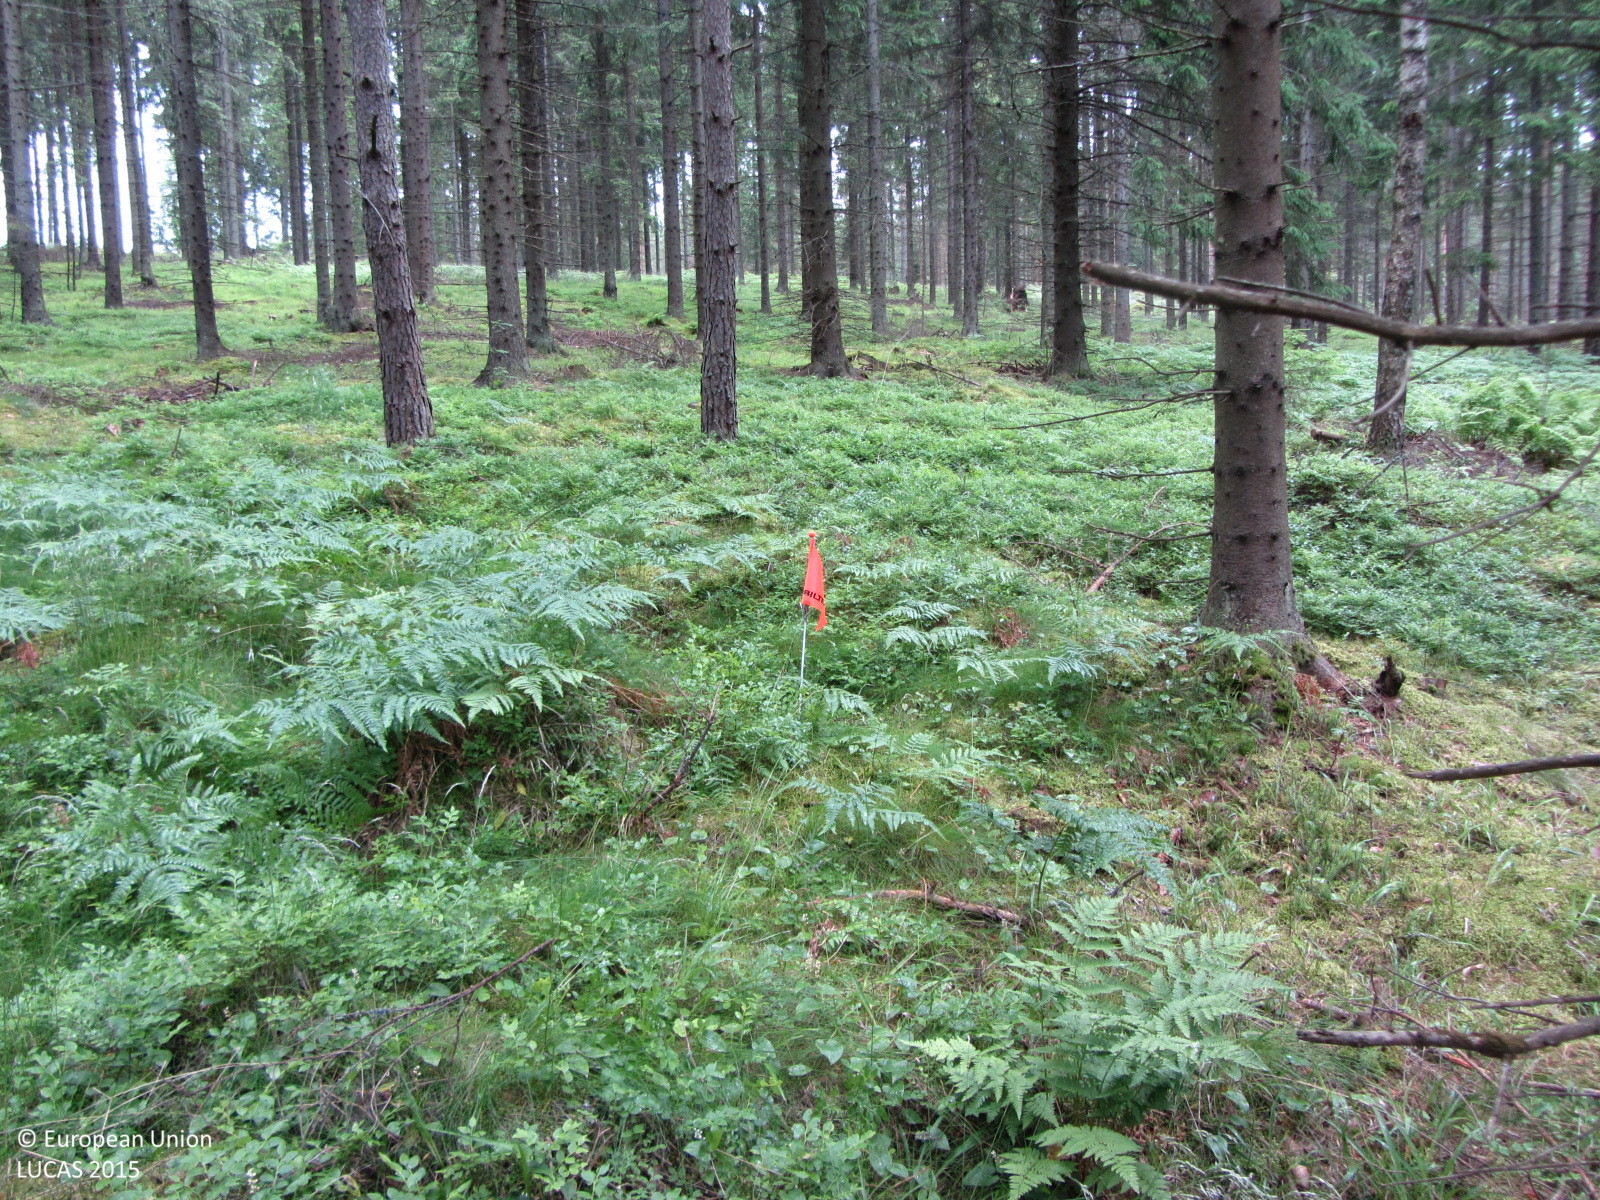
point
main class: Woodland
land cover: Spruce dominated coniferous woodland
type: boreal forest
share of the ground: > 75 %
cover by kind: coniferous forest trees 70 %, herbaceous plants 15 %, broadleaved forest trees 5 %, shrubs 5 %, lichens and mosses 5 %
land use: Forestry
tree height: > 5 m
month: June
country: FI
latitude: 60.1972
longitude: 23.1967
